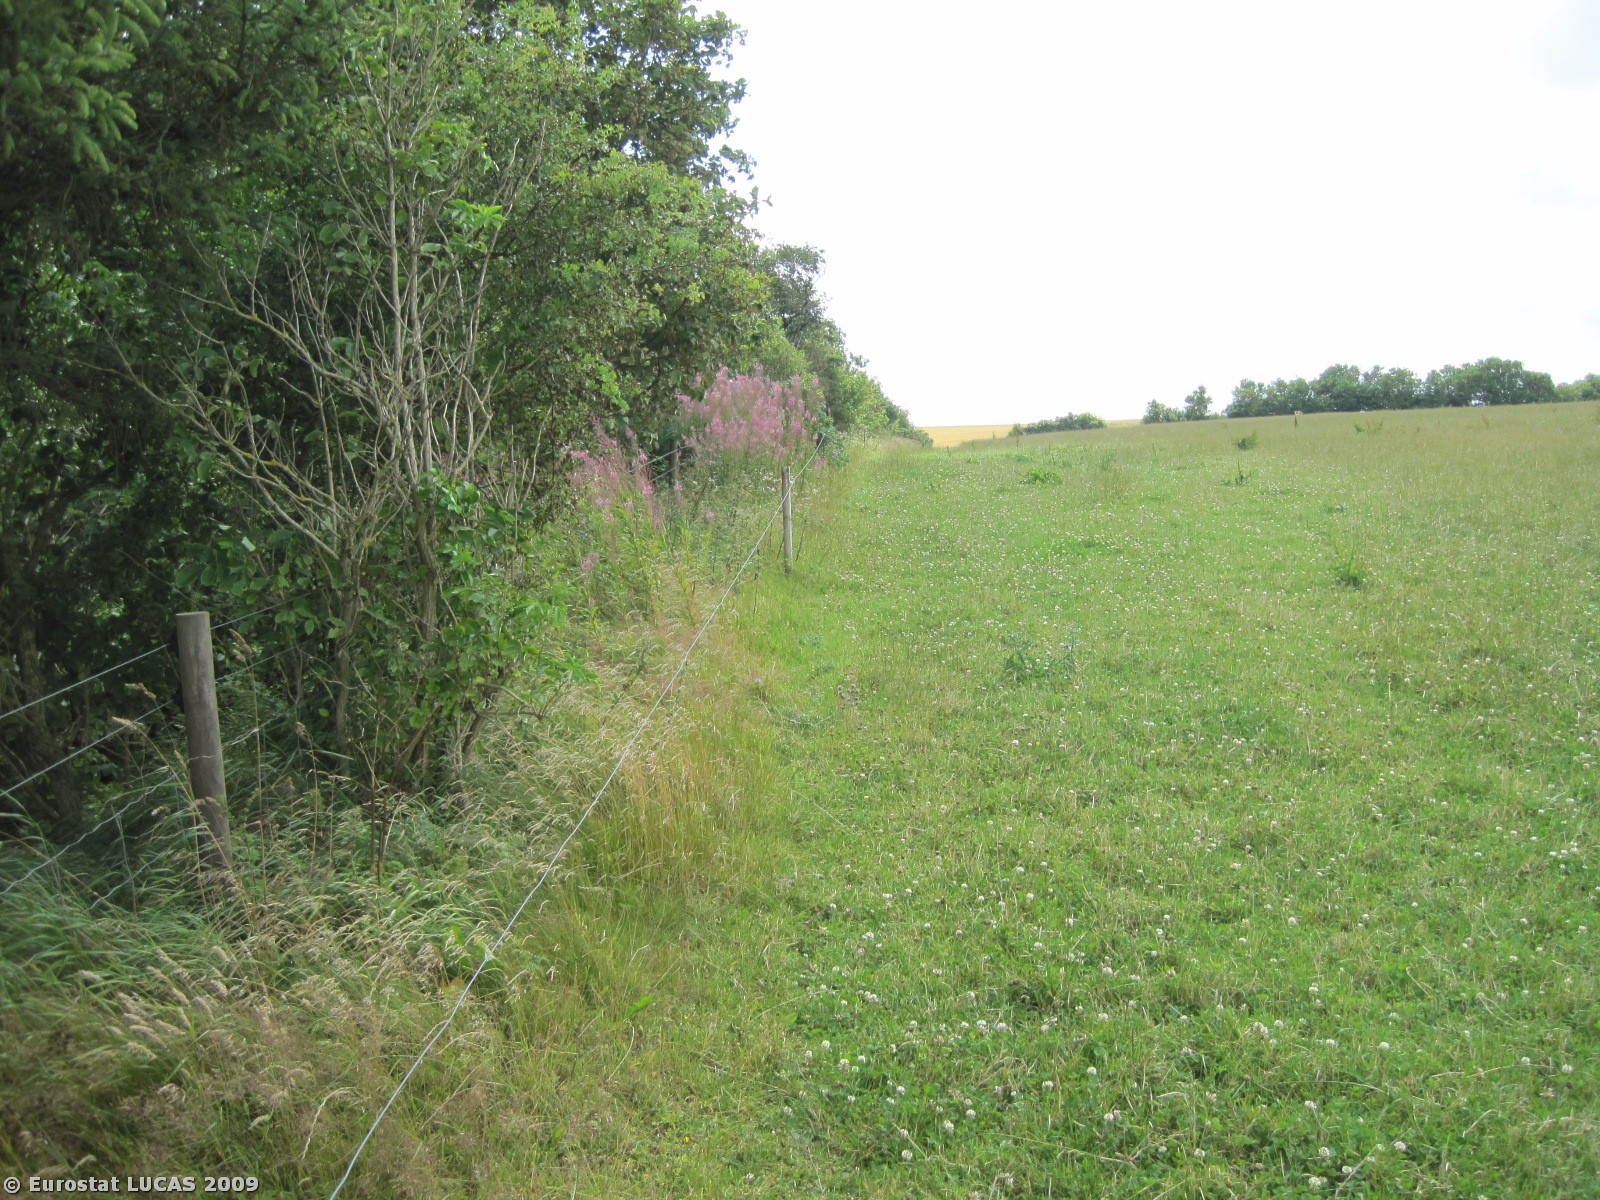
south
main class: Grassland
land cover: Grassland with sparse tree/shrub cover
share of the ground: > 75 %
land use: Unused
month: July
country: DK
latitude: 56.8620
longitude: 8.4767
